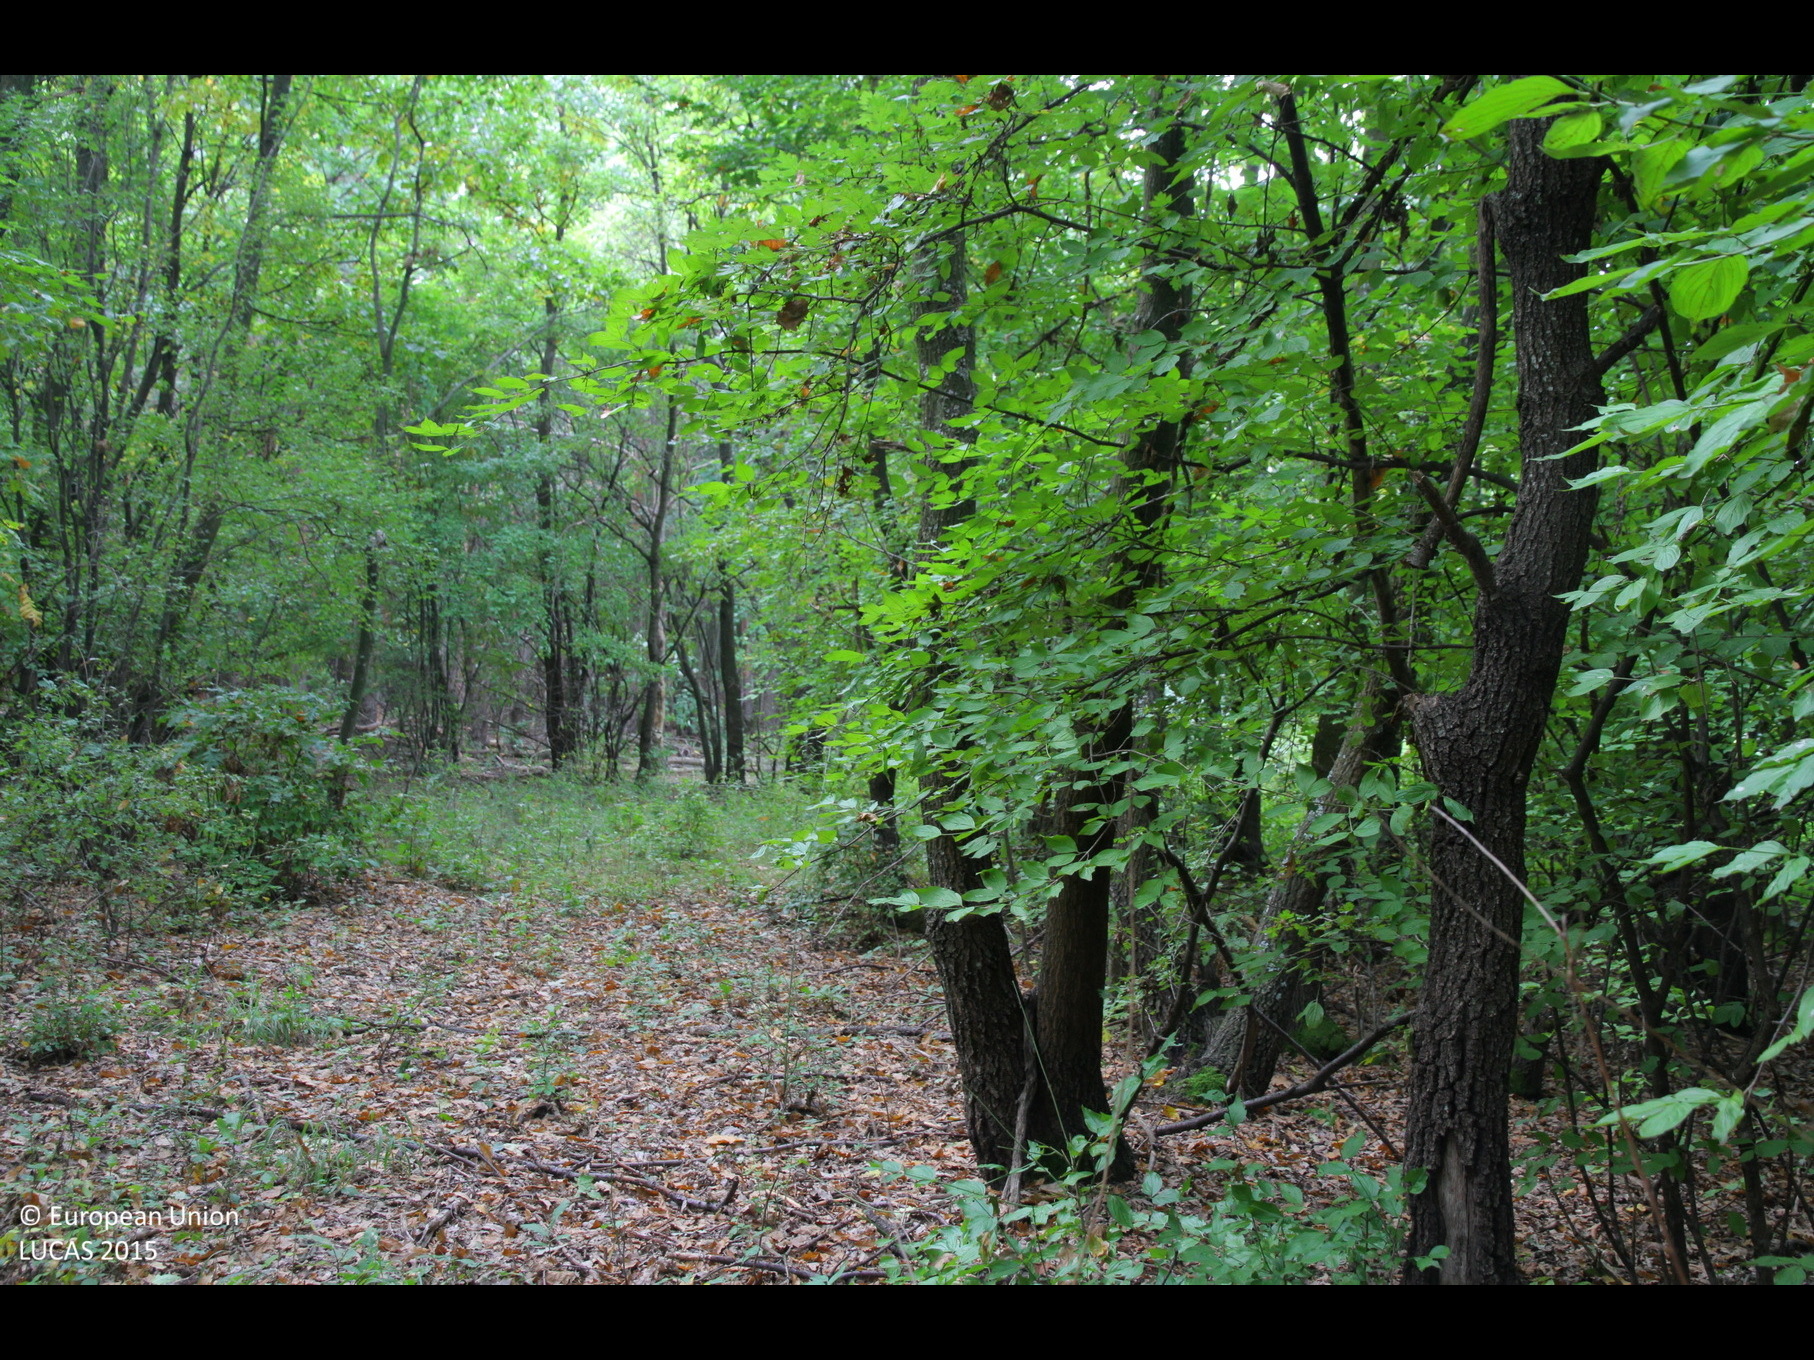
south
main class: Woodland
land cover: Broadleaved woodland
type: mesophytic deciduous forest
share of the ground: > 75 %
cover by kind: broadleaved forest trees 95 %, shrubs 5 %
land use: Forestry
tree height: > 5 m
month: October
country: BG
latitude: 43.5622
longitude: 26.9922
